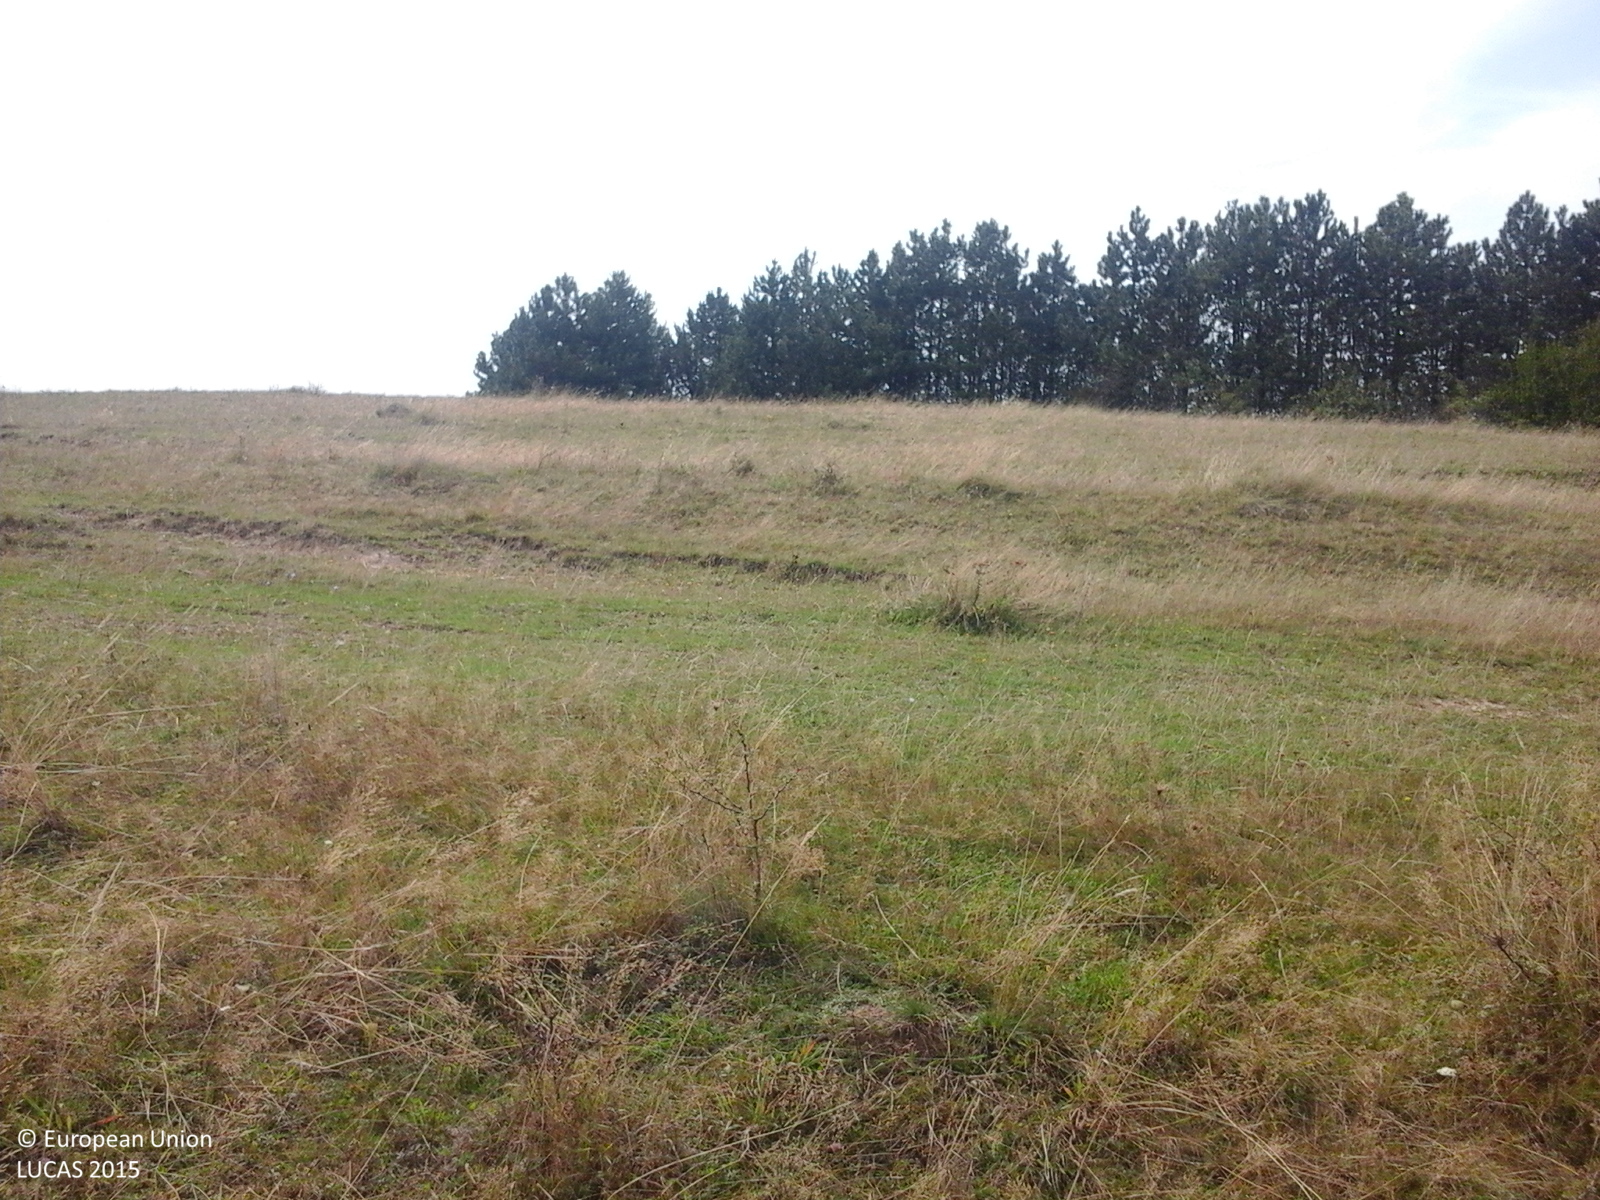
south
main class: Grassland
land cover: Grassland with sparse tree/shrub cover
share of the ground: > 75 %
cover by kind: herbaceous plants 85 %, shrubs 10 %, broadleaved forest trees 5 %
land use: Fallow land
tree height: < 5 m
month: September
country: RO
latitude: 47.1589
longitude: 23.7278
